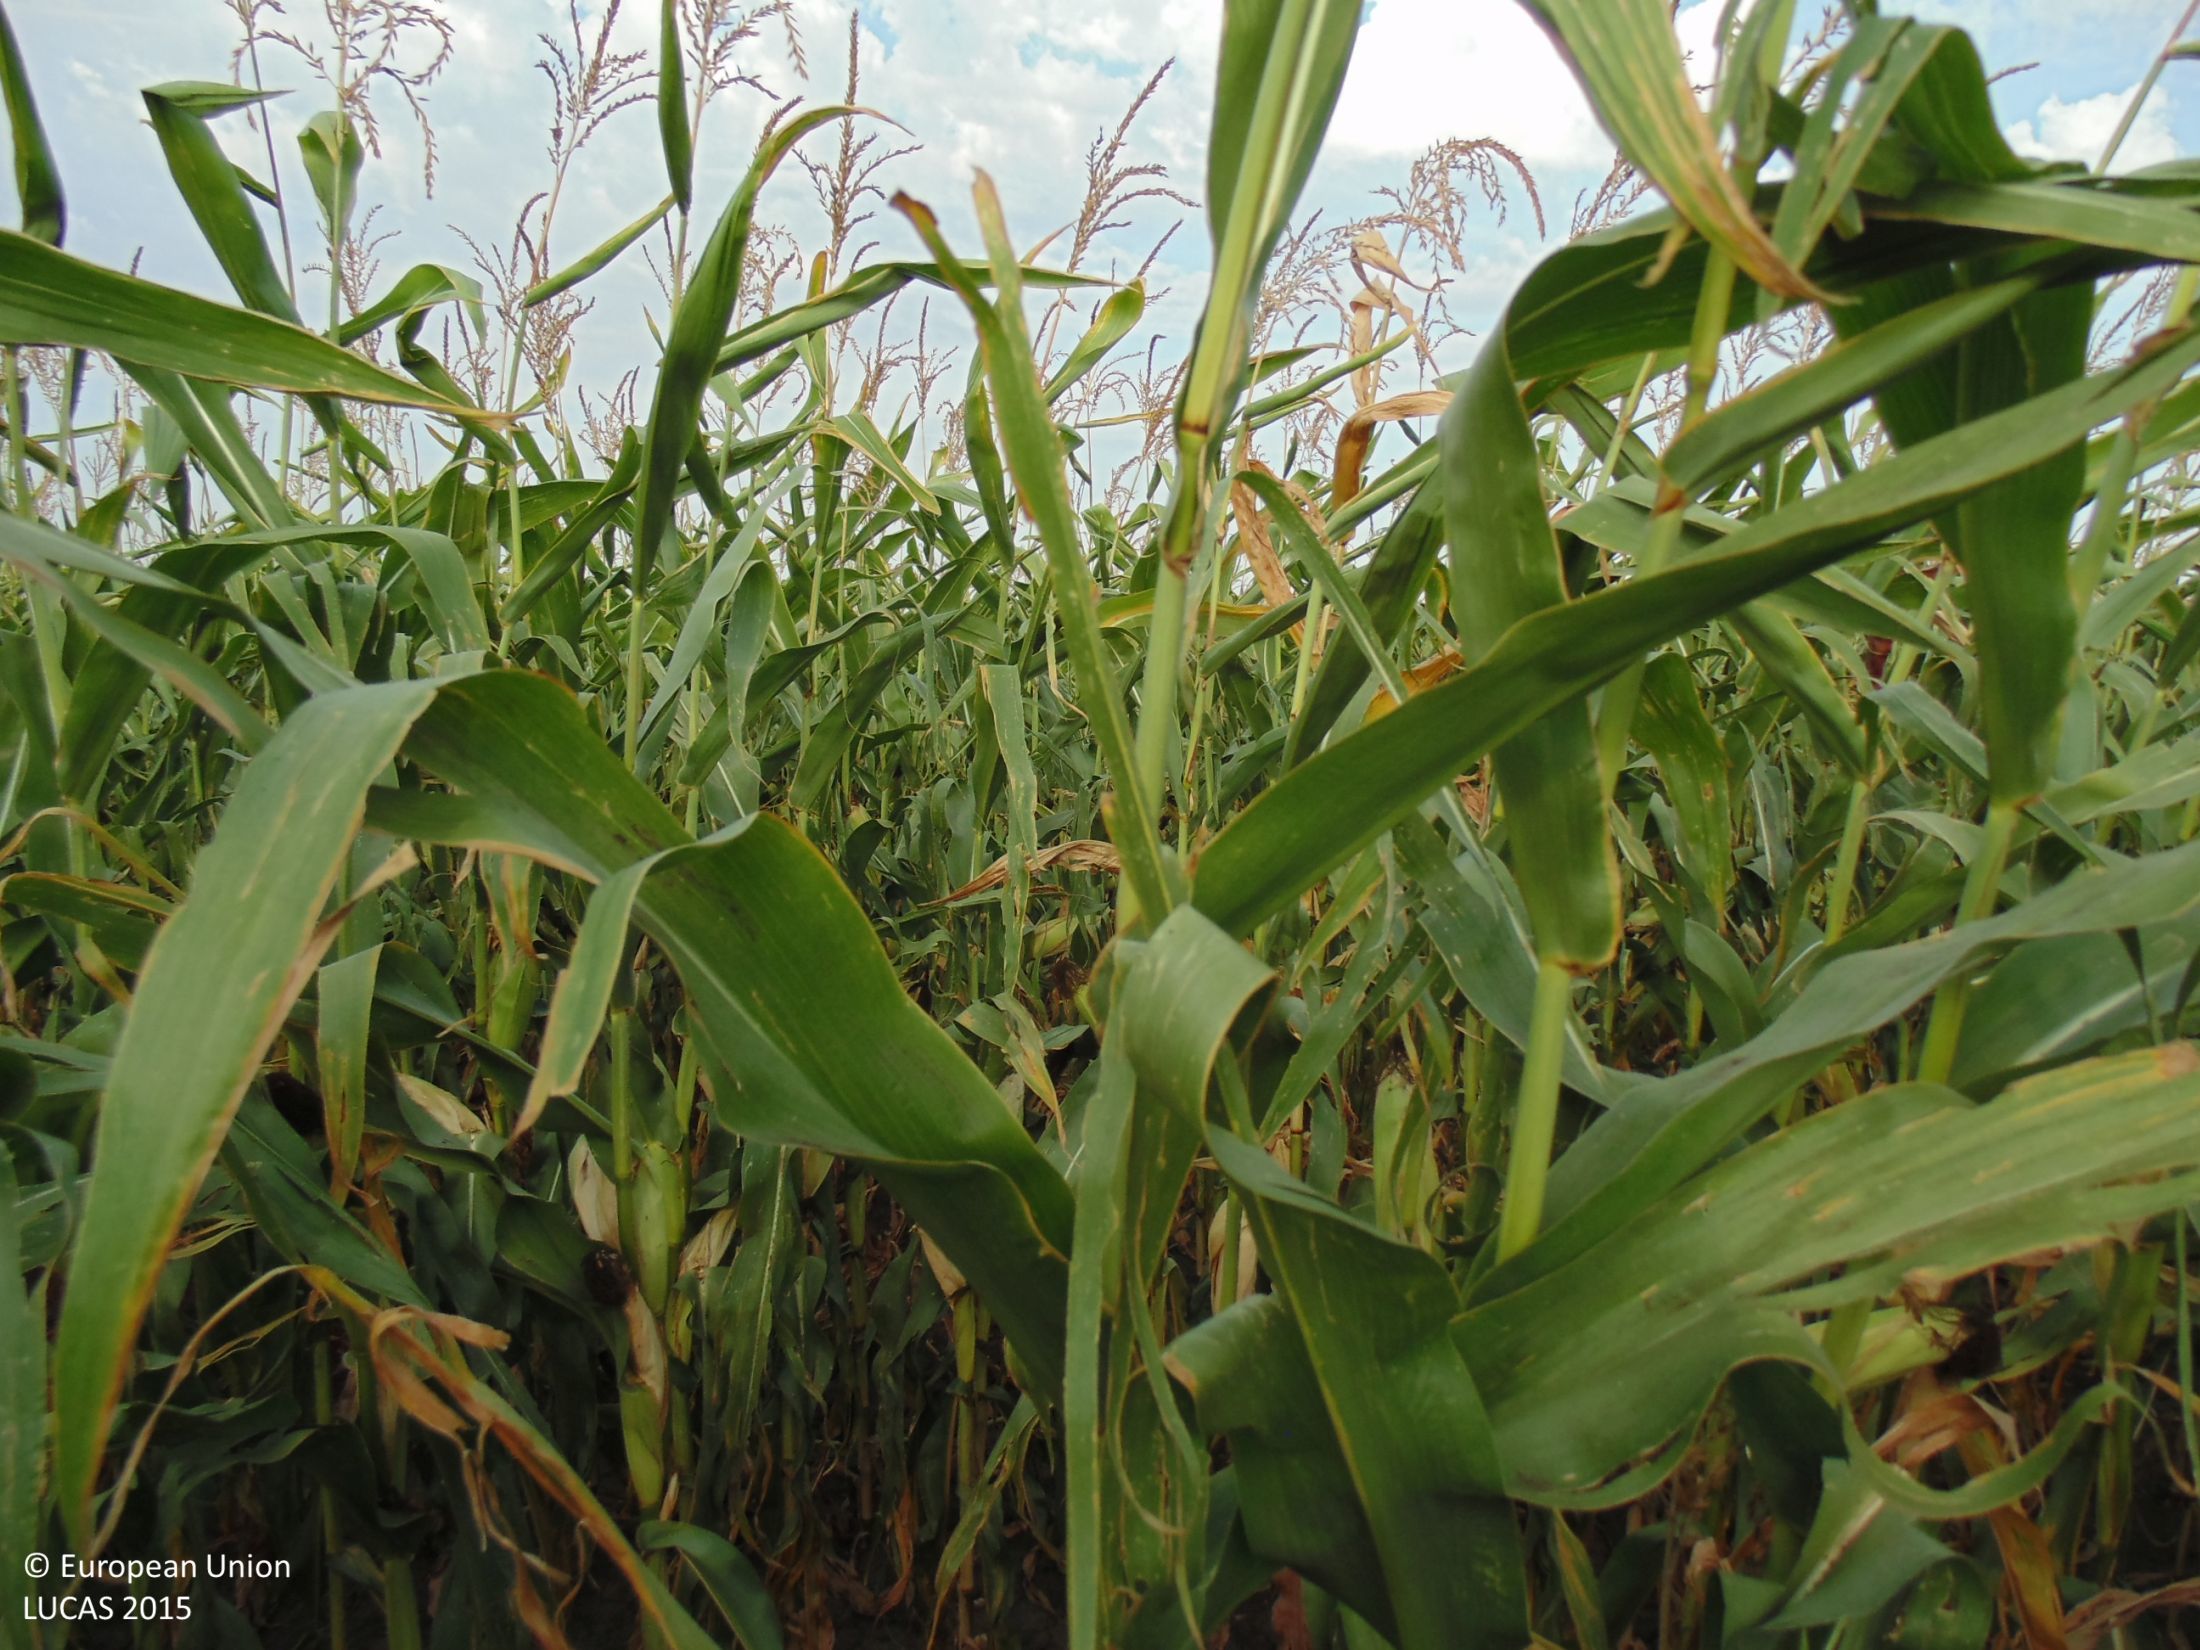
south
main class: Cropland
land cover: Maize
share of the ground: > 75 %
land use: Agriculture (excluding fallow land and kitchen gardens)
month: August
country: BG
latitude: 43.7007
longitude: 28.2091
